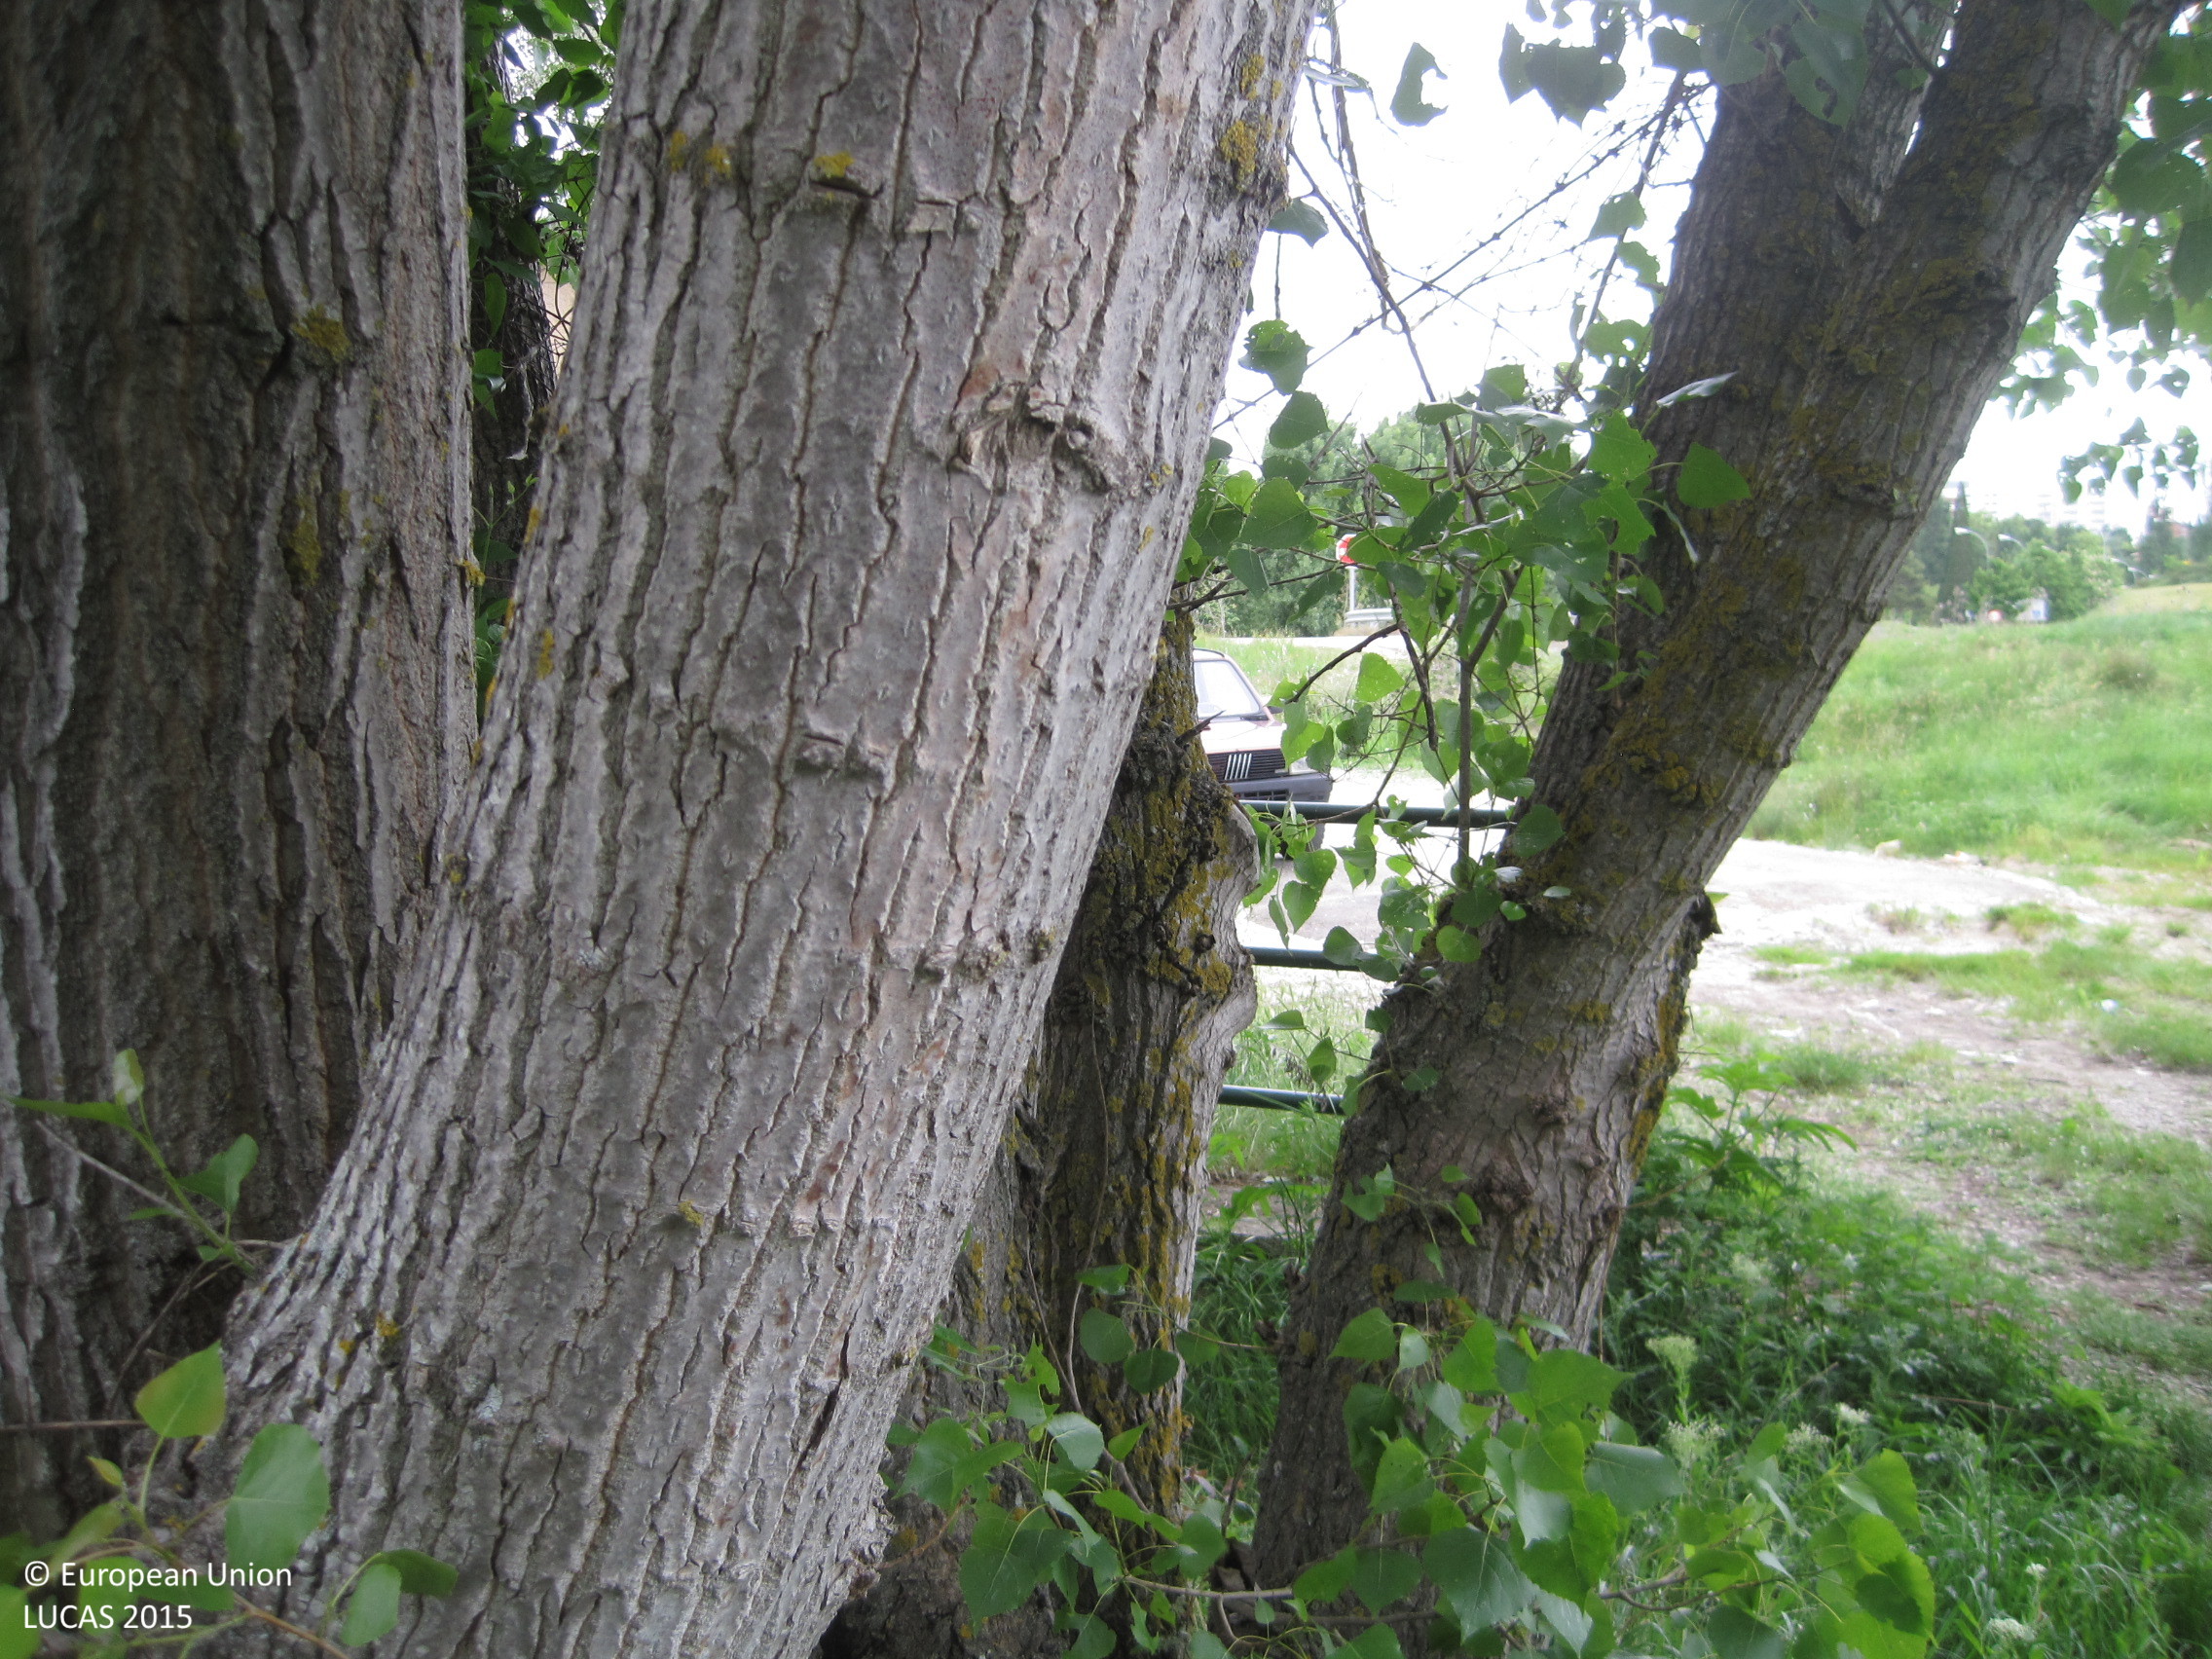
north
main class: Woodland
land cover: Broadleaved woodland
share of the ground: > 75 %
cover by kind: broadleaved forest trees 100 %
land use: Semi-natural and natural areas not in use
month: May
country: ES
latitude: 42.7975
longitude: -1.6667
